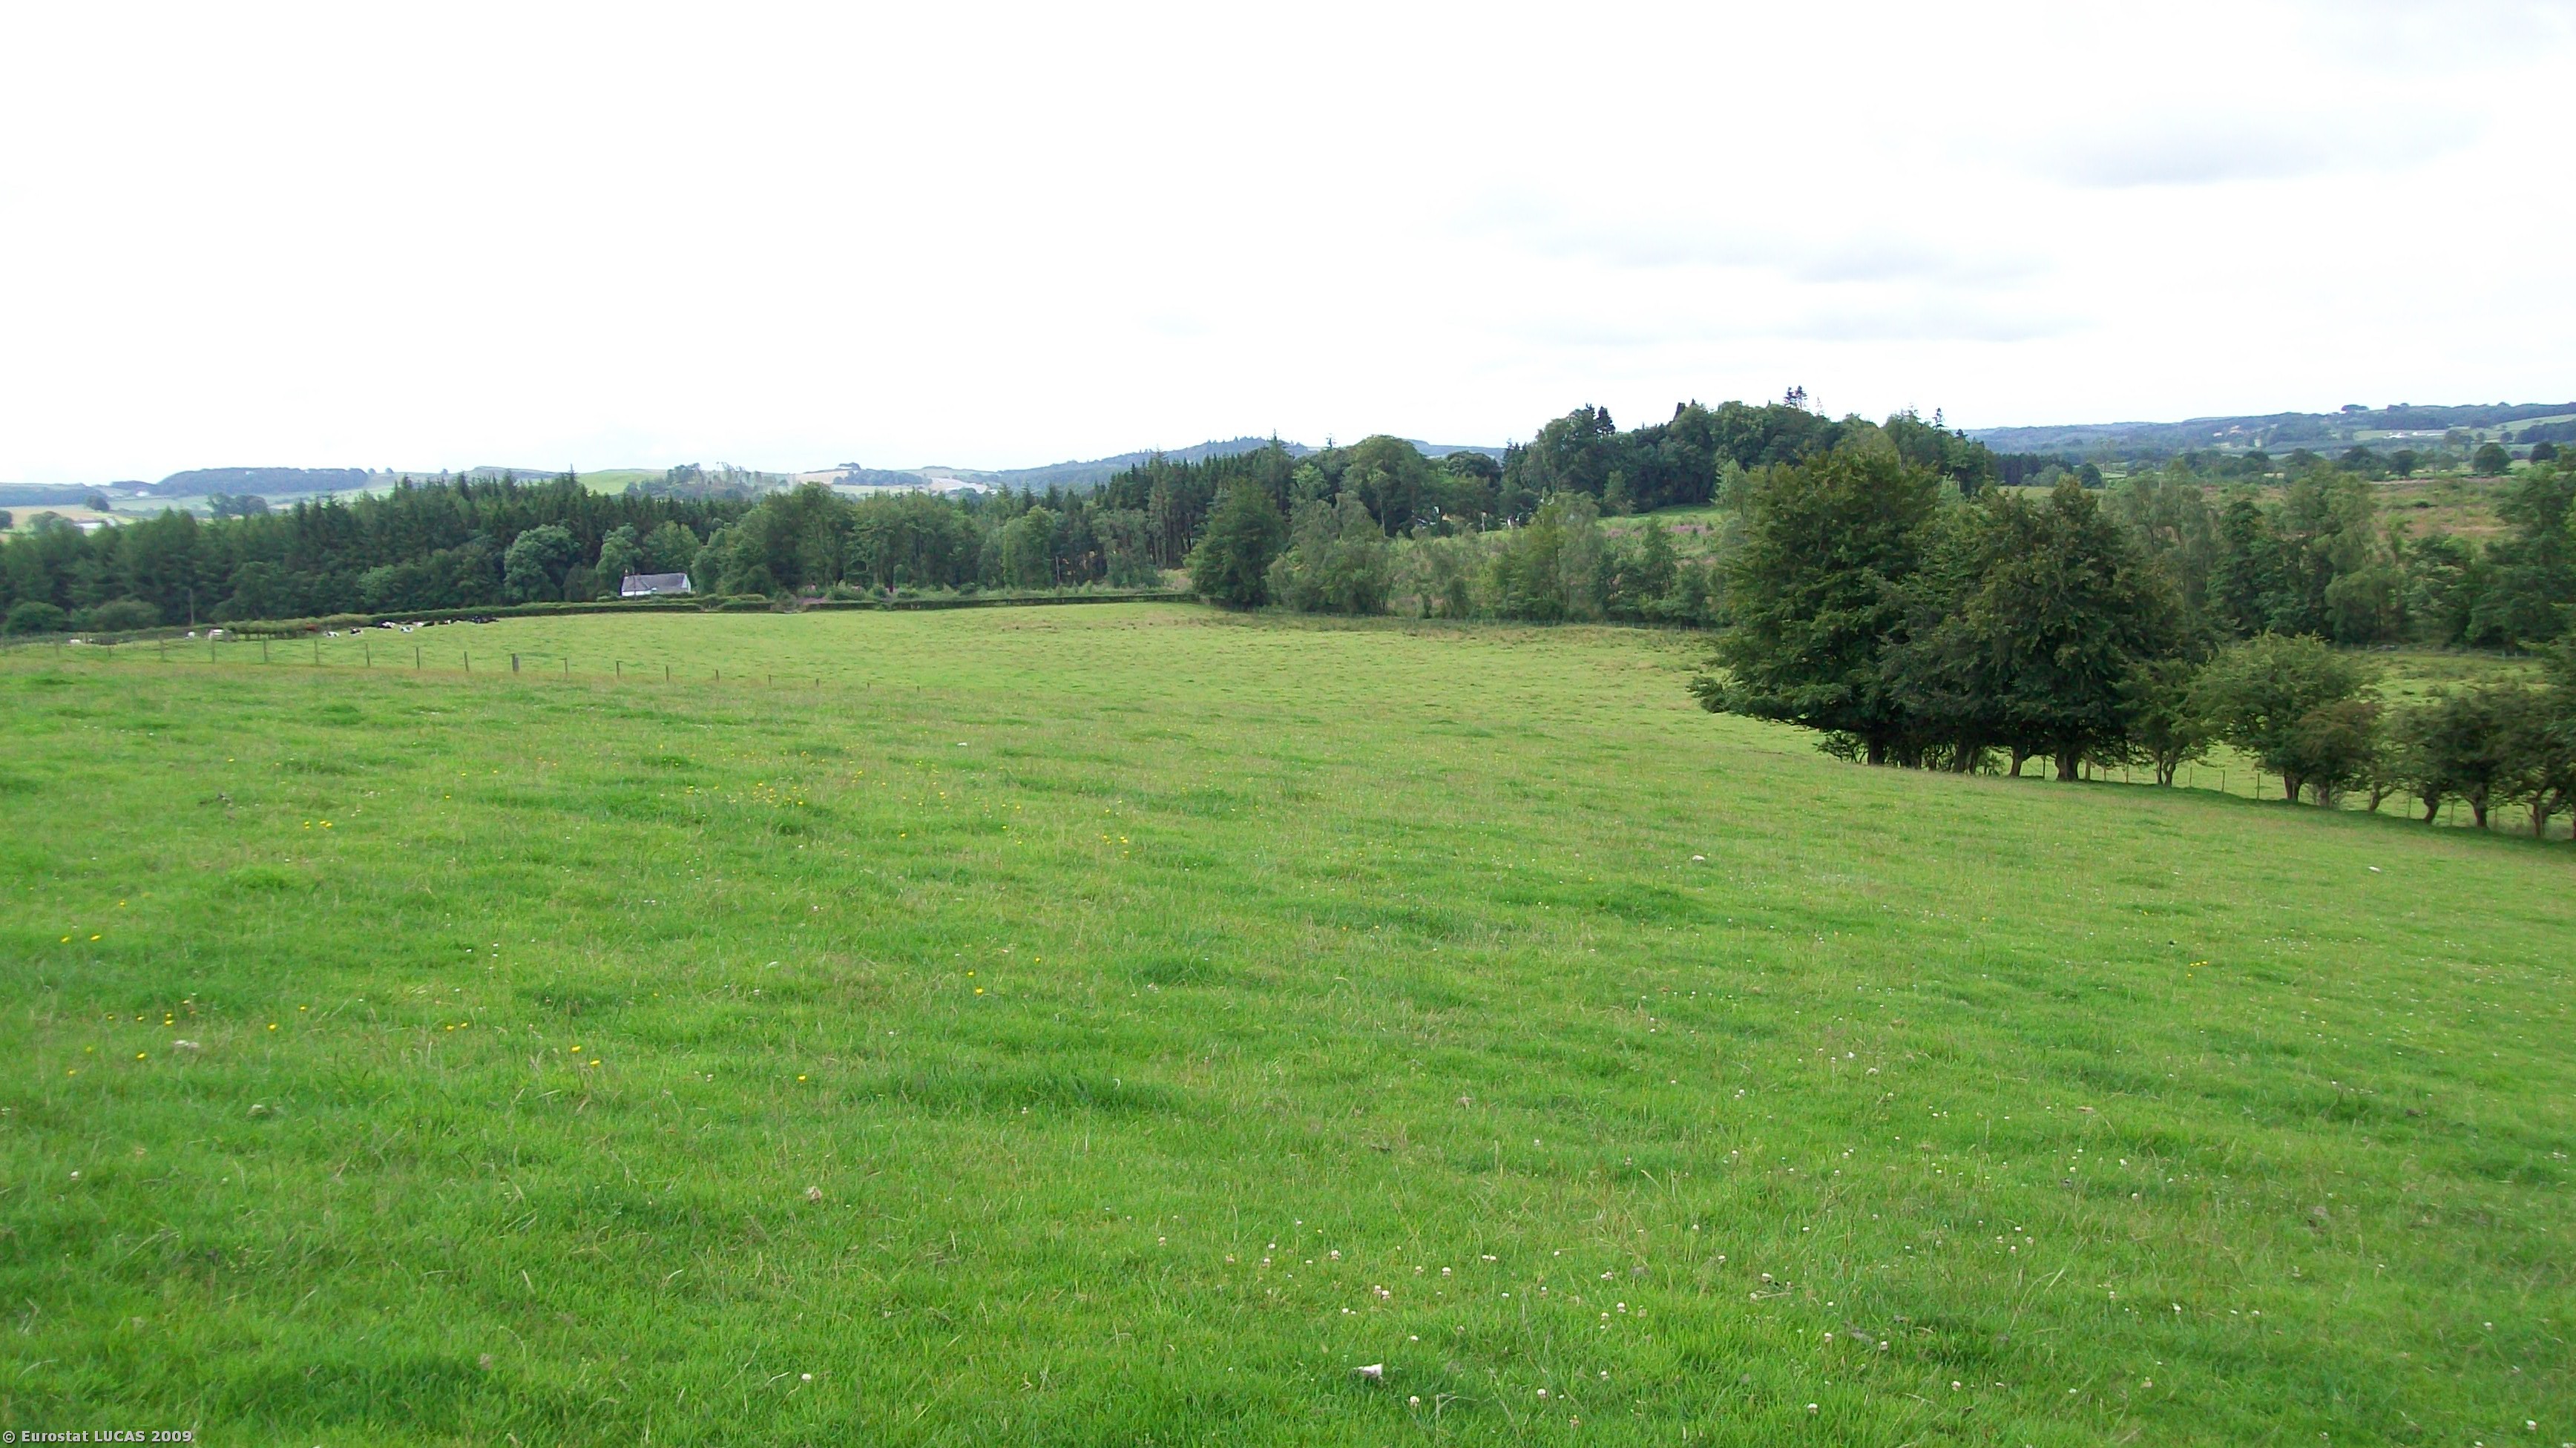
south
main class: Grassland
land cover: Grassland without tree/shrub cover
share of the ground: > 75 %
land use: Agriculture (excluding fallow land and kitchen gardens)
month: July
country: GB
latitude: 55.1234
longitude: -3.3276
